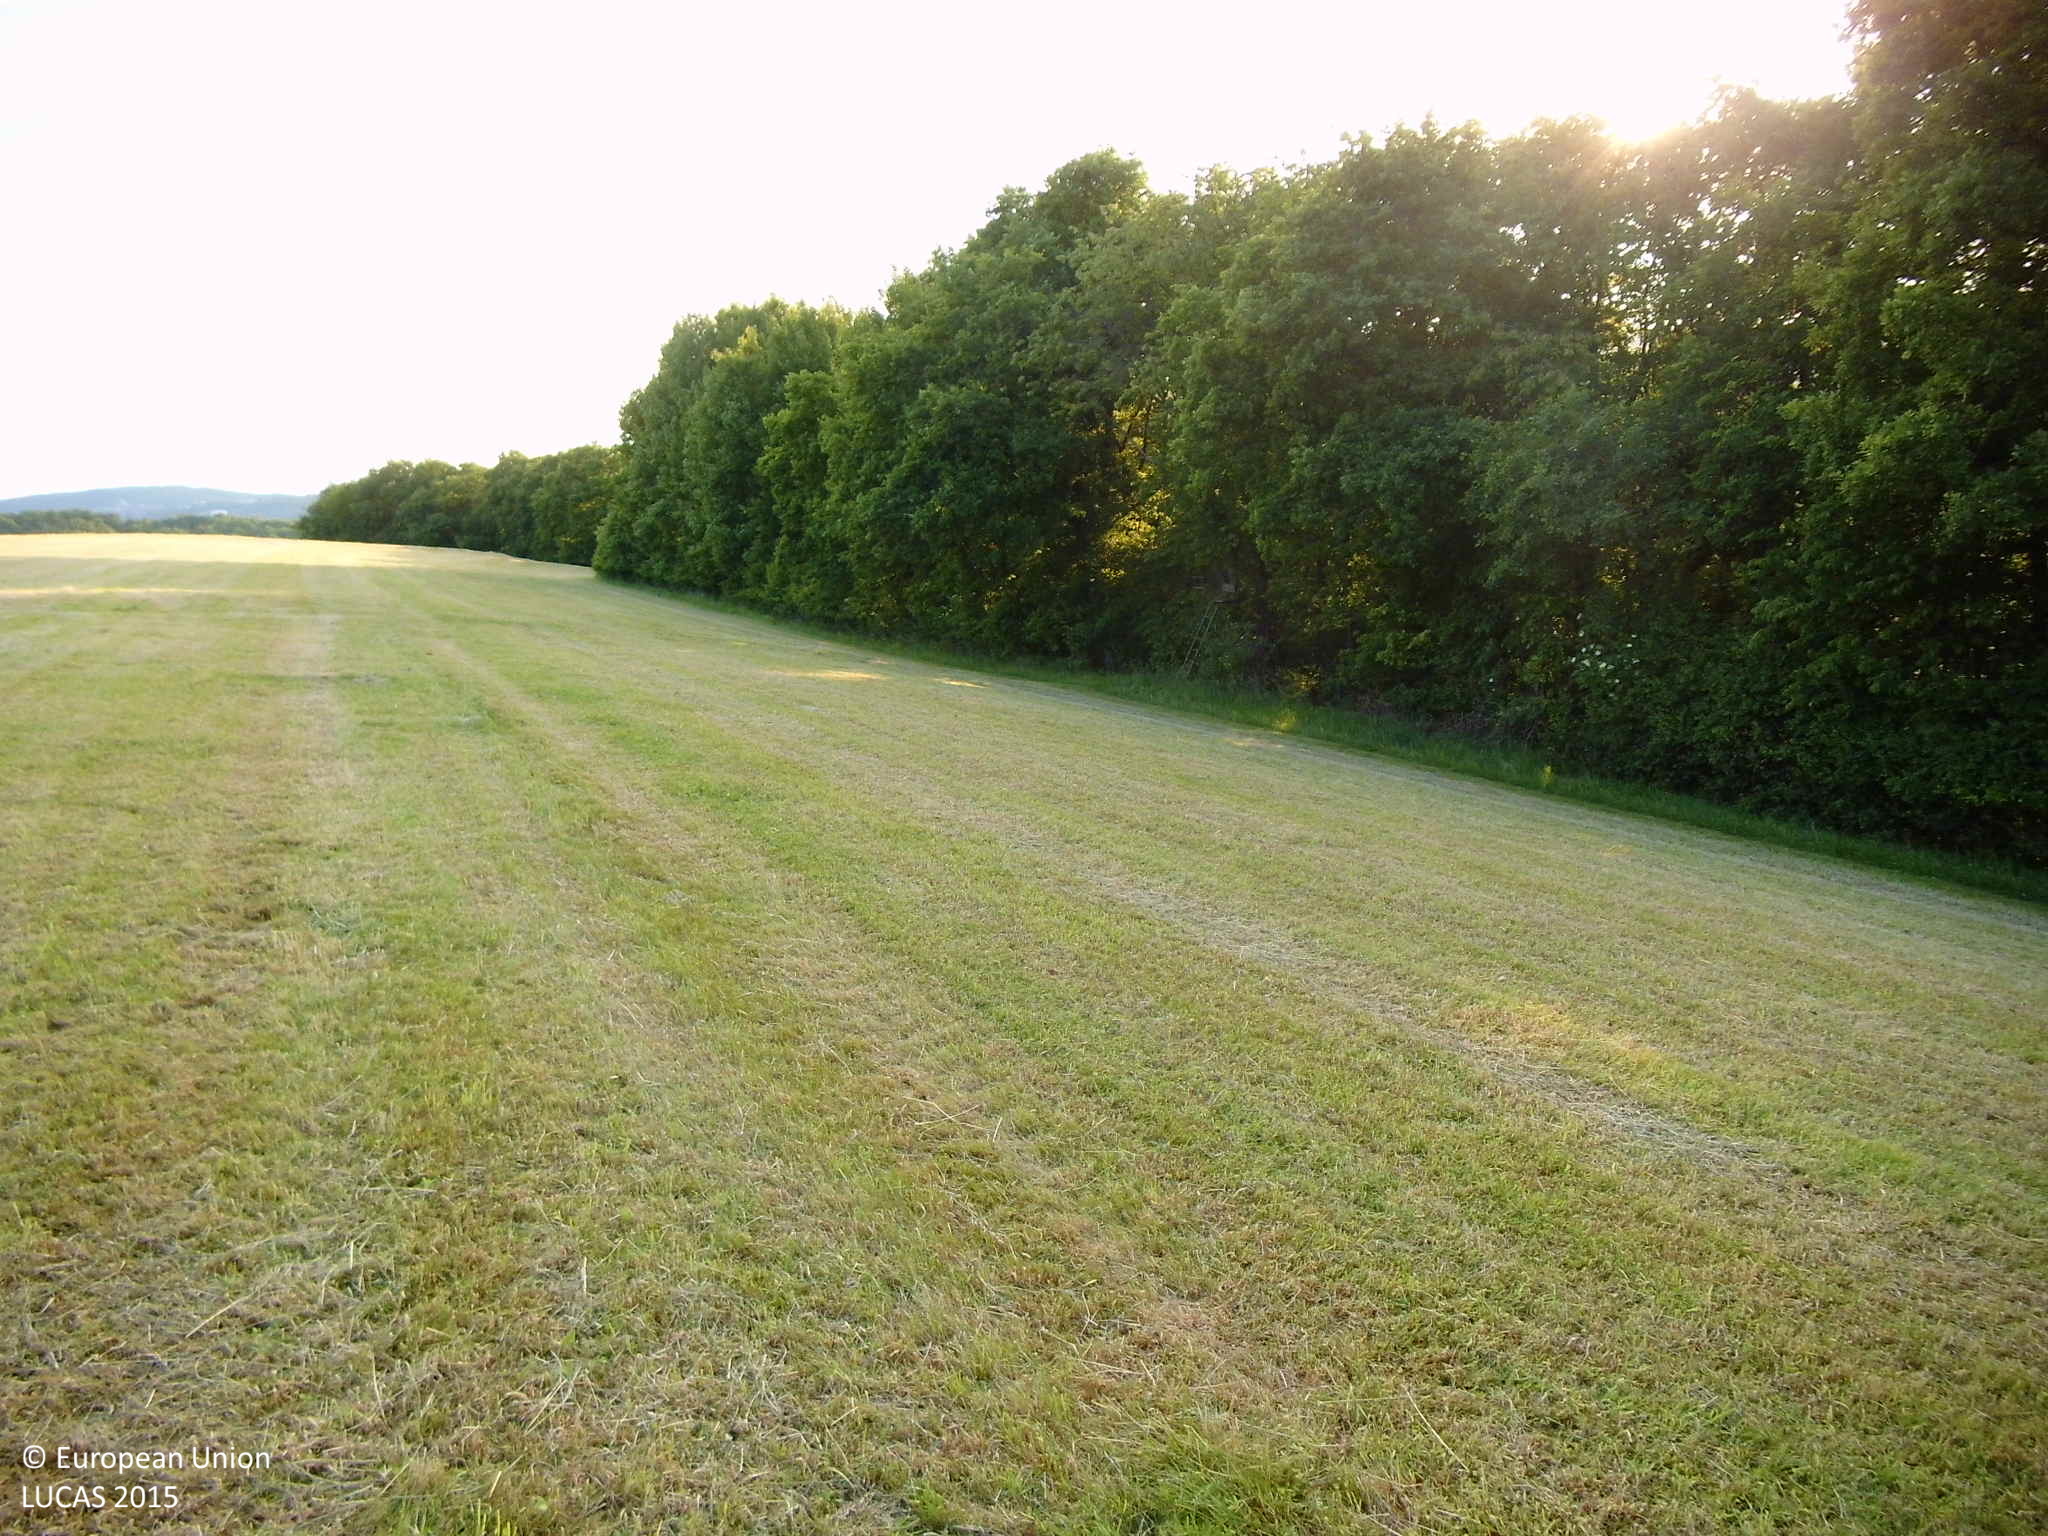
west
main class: Grassland
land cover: Grassland without tree/shrub cover
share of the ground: > 75 %
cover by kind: herbaceous plants 100 %
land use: Agriculture (excluding fallow land and kitchen gardens)
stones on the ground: 10 - 25 %
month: June
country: DE
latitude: 50.9235
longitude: 8.0798
